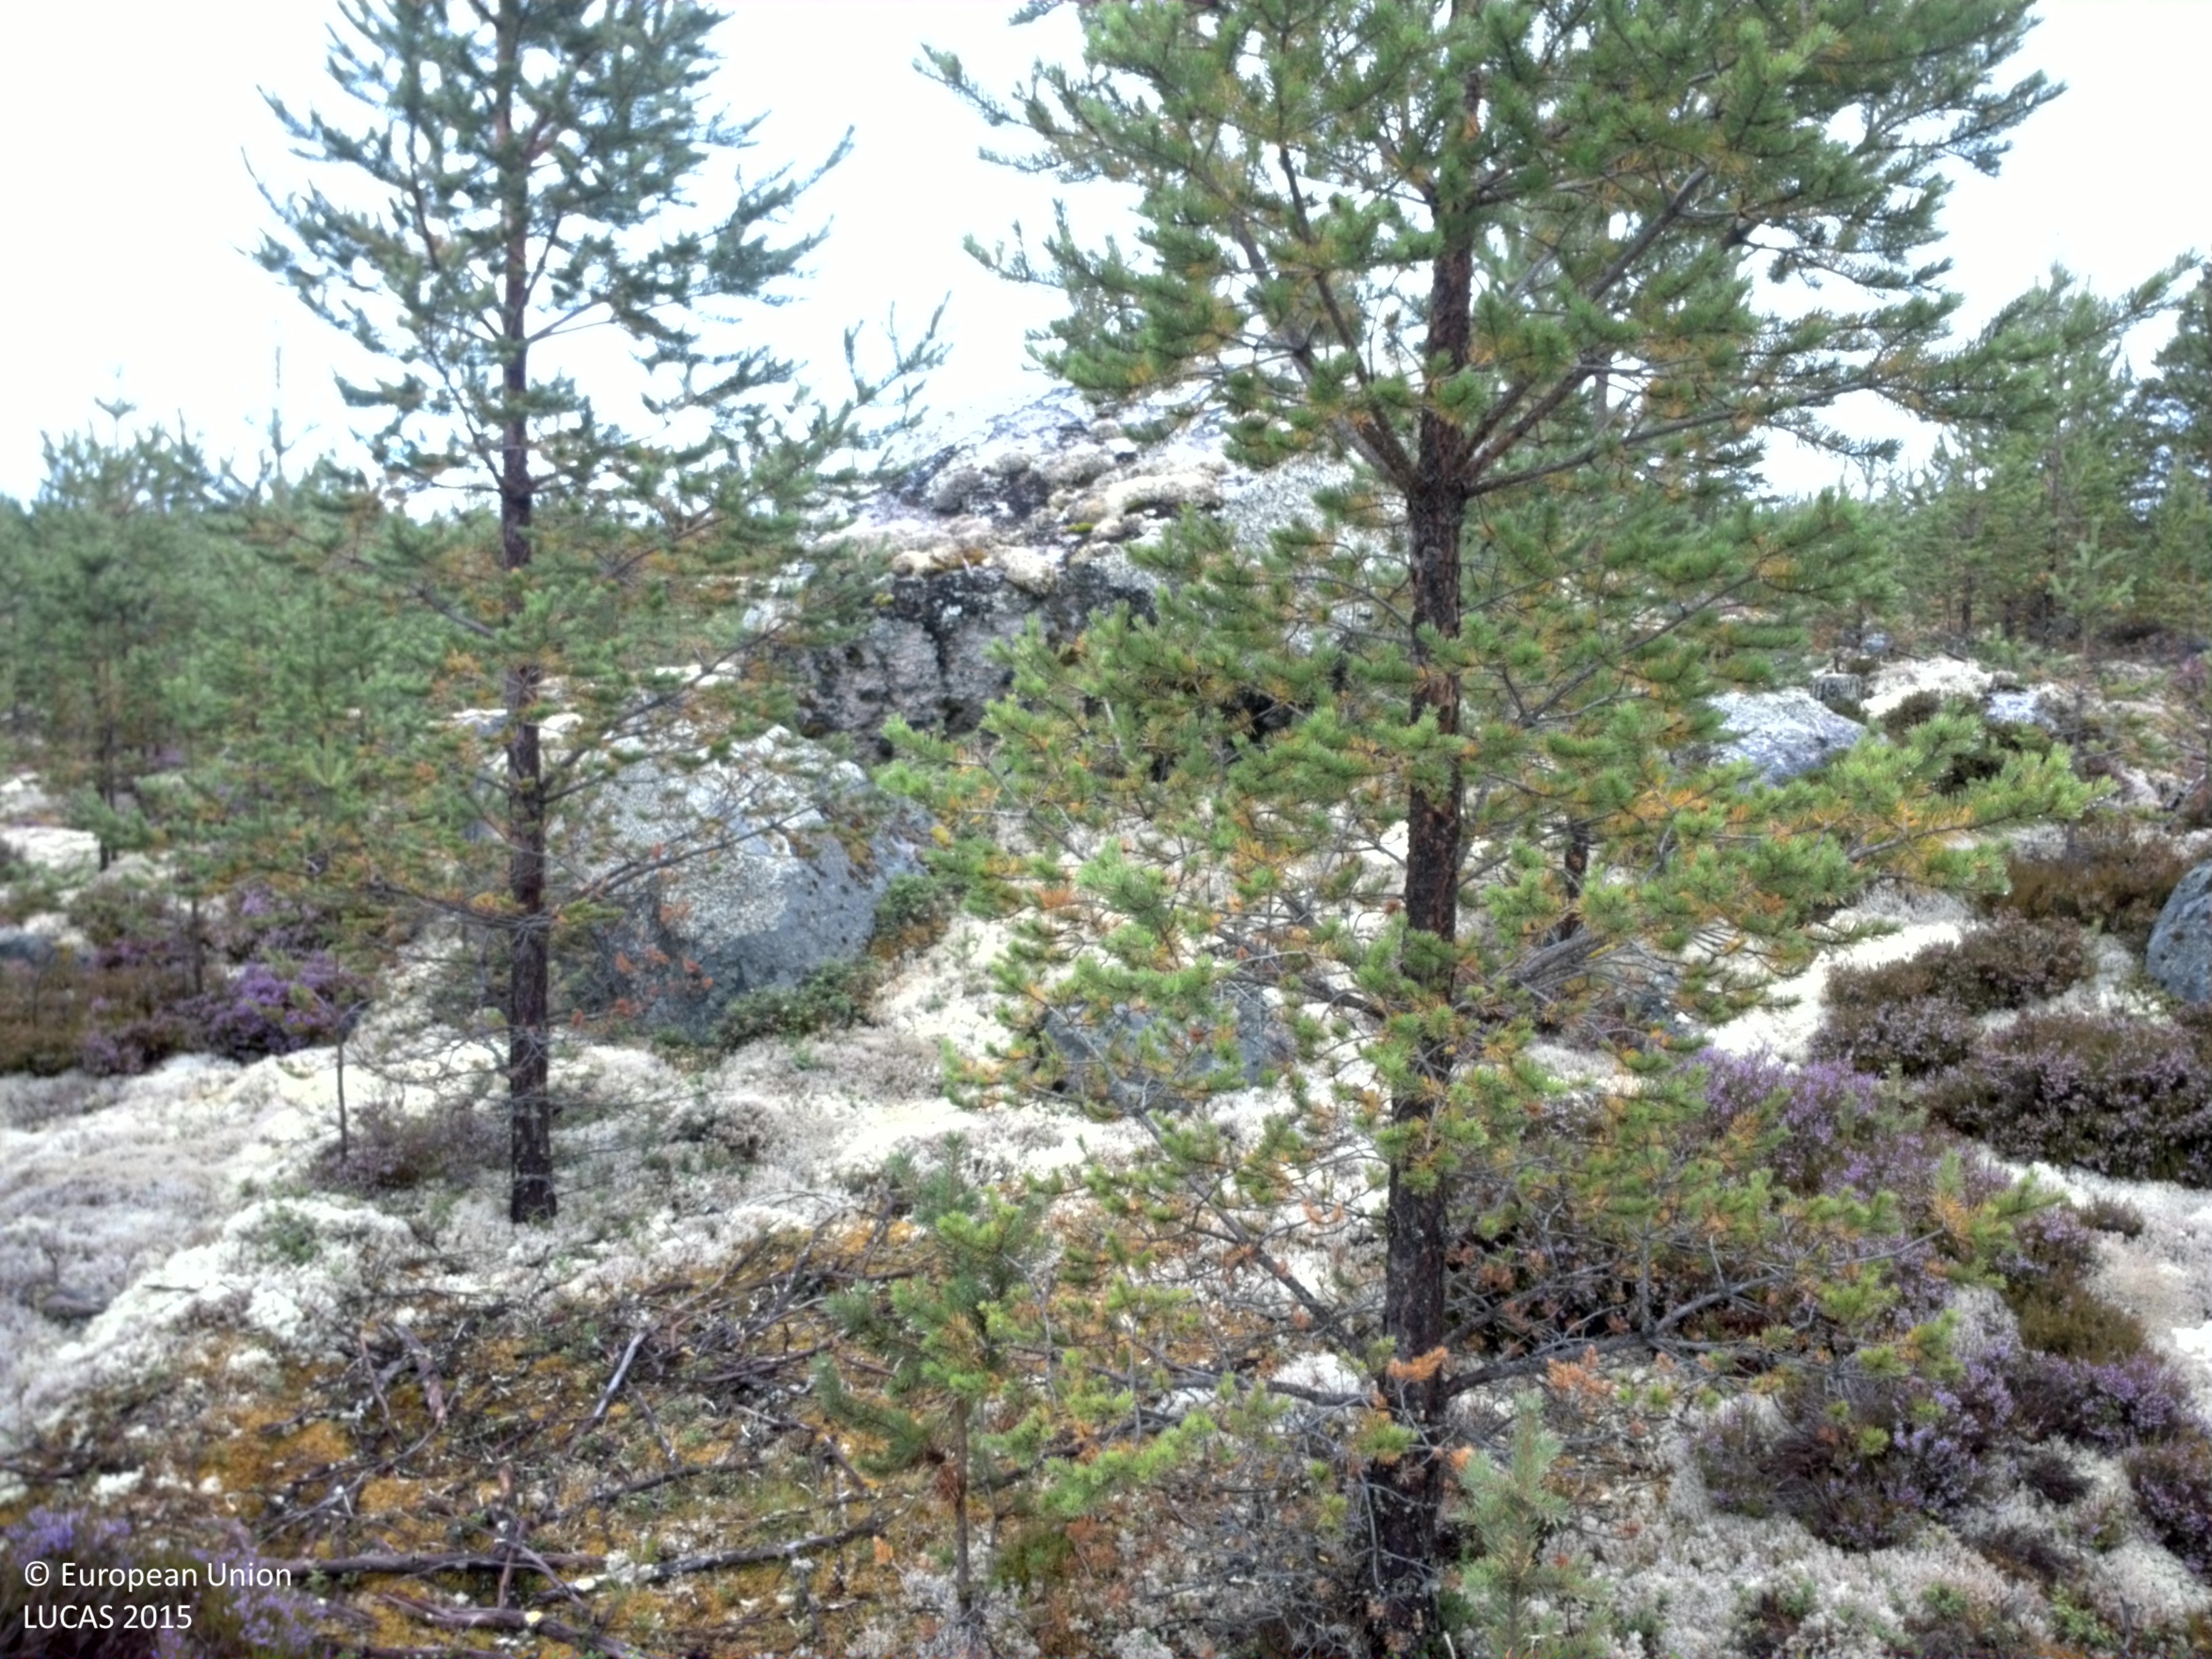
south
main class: Woodland
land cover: Pine dominated coniferous woodland
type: boreal forest
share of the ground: 10 - 25 %
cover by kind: shrubs 45 %, lichens and mosses 25 %, coniferous forest trees 20 %, consolidated bare surface 10 %
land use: Forestry
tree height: < 5 m
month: August
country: SE
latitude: 61.8282
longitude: 14.9009
